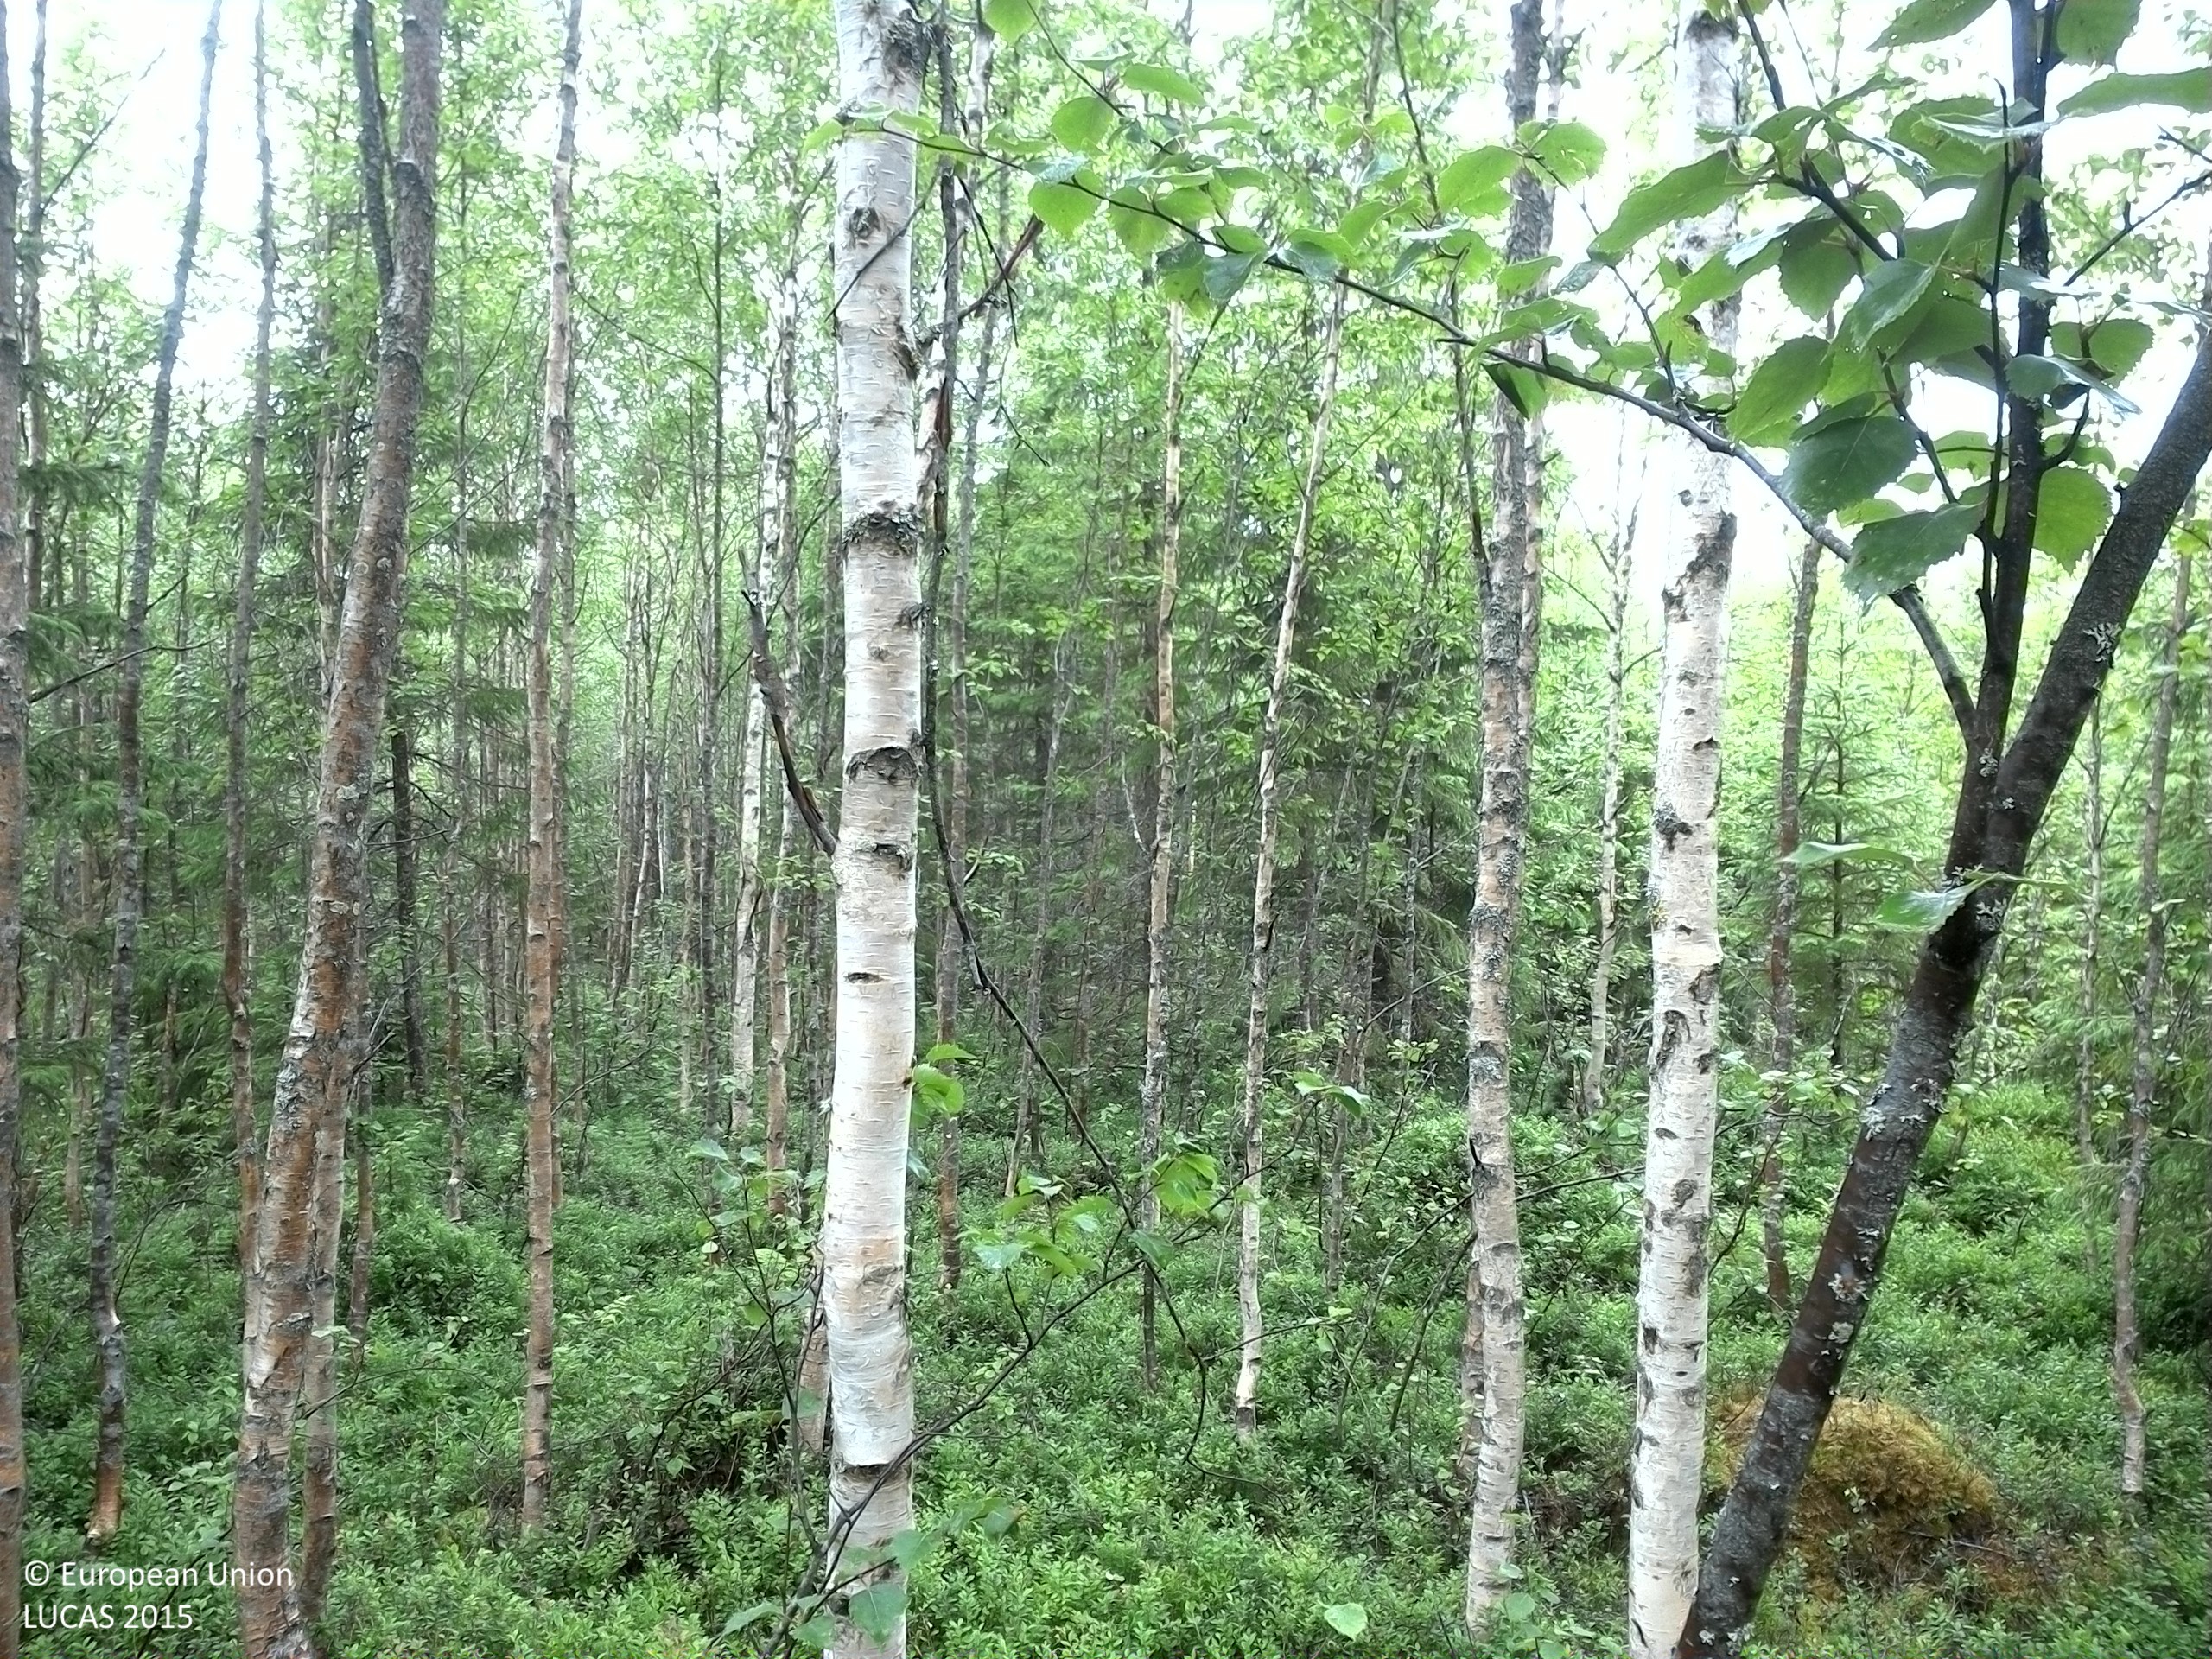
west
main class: Woodland
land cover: Spruce dominated mixed woodland
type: boreal forest
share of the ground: > 75 %
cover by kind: coniferous forest trees 45 %, broadleaved forest trees 40 %, shrubs 15 %
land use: Forestry
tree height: > 5 m
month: July
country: SE
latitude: 62.6726
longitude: 17.2618
